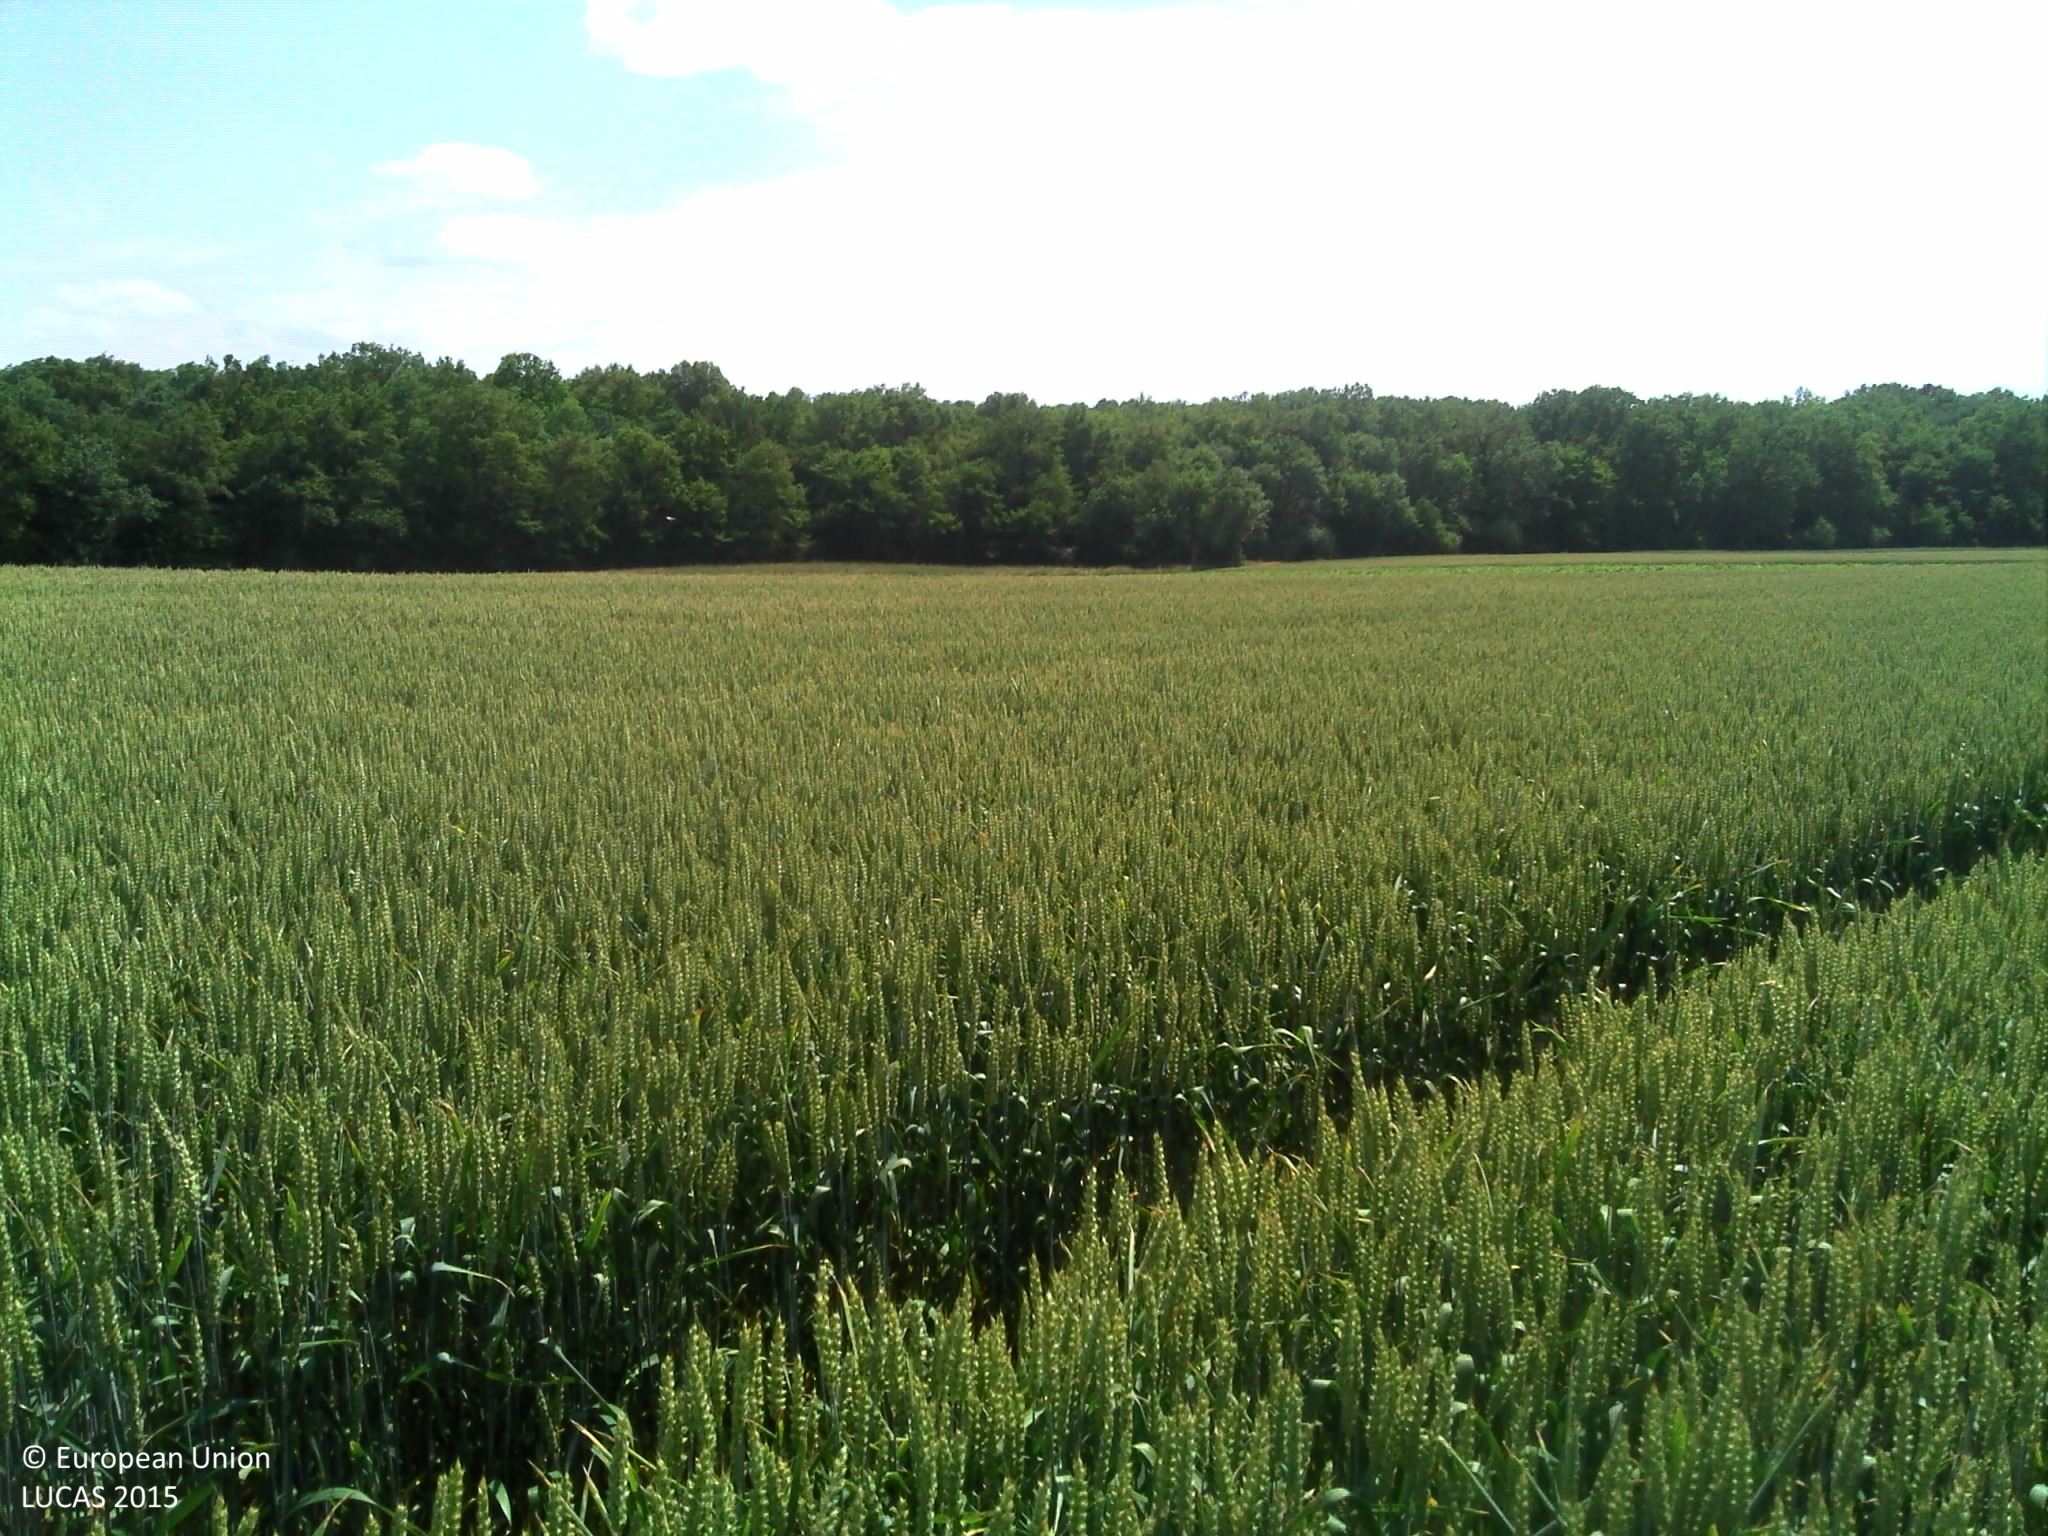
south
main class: Cropland
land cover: Common wheat
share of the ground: > 75 %
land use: Agriculture (excluding fallow land and kitchen gardens)
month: June
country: FR
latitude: 47.2331
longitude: 3.1403
